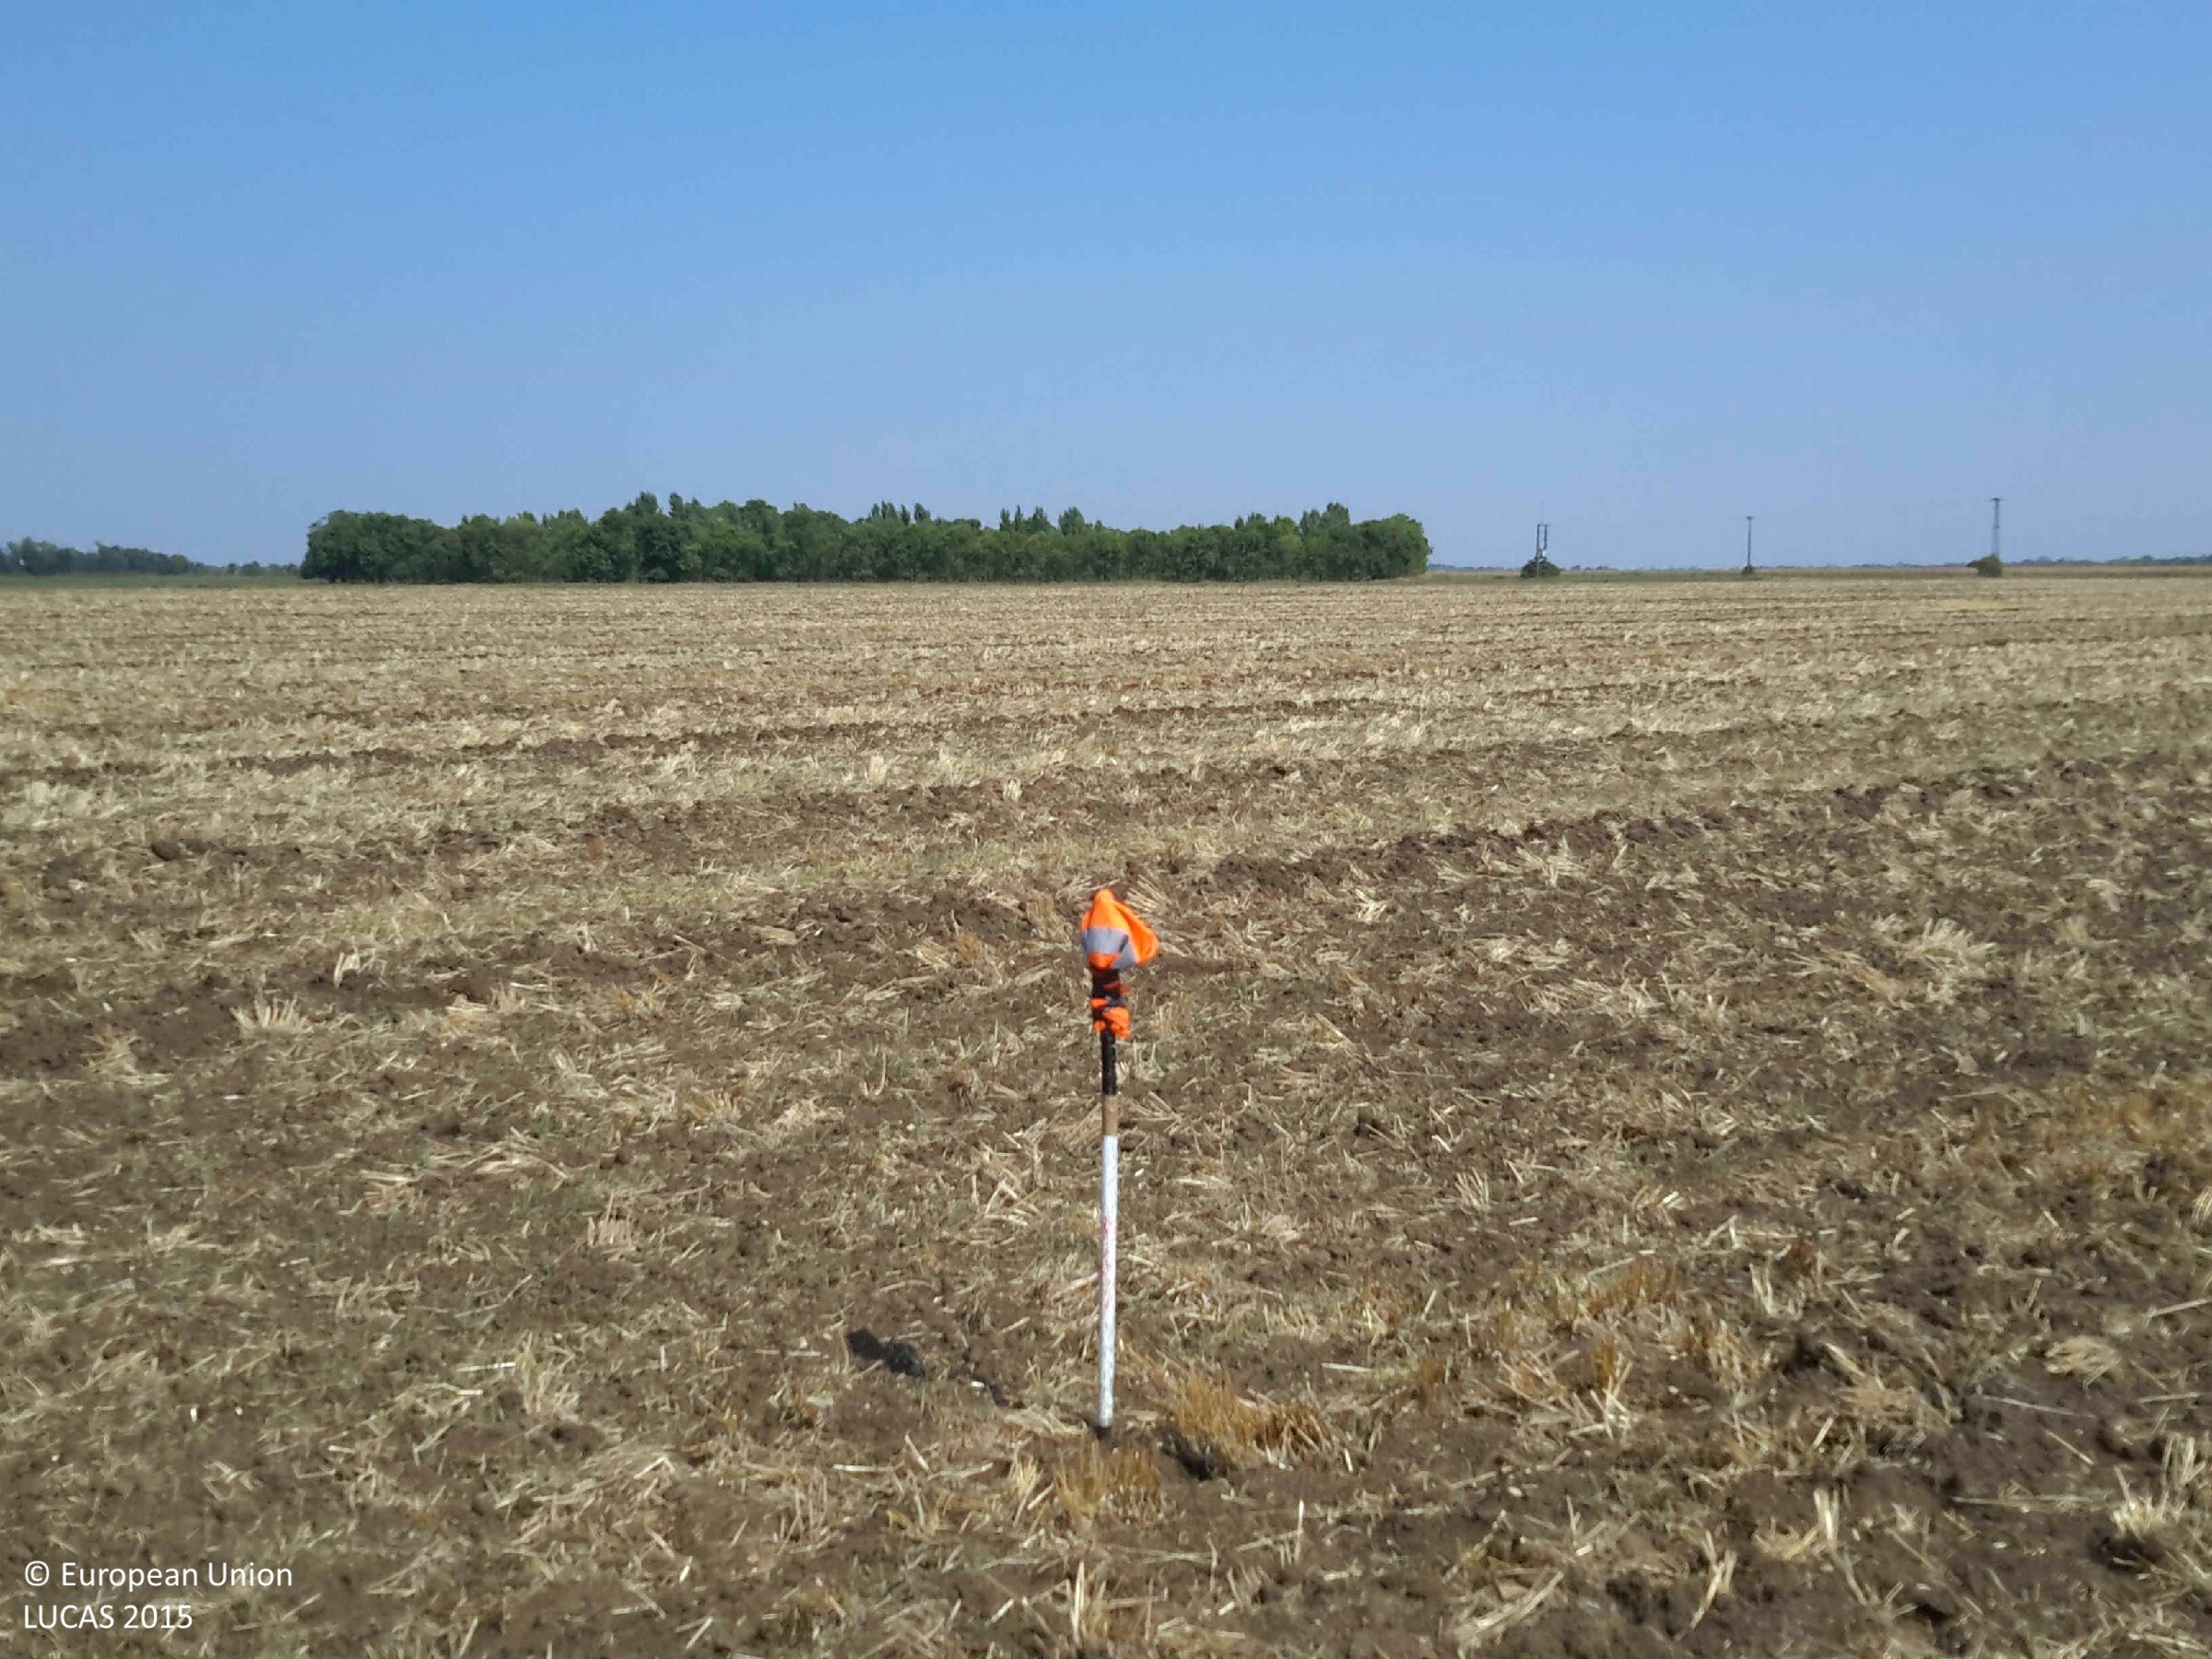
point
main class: Cropland
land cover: Durum wheat
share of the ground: < 10 %
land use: Agriculture (excluding fallow land and kitchen gardens)
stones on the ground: < 10 %
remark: Harvested field
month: August
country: HU
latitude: 47.8301
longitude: 17.1275
